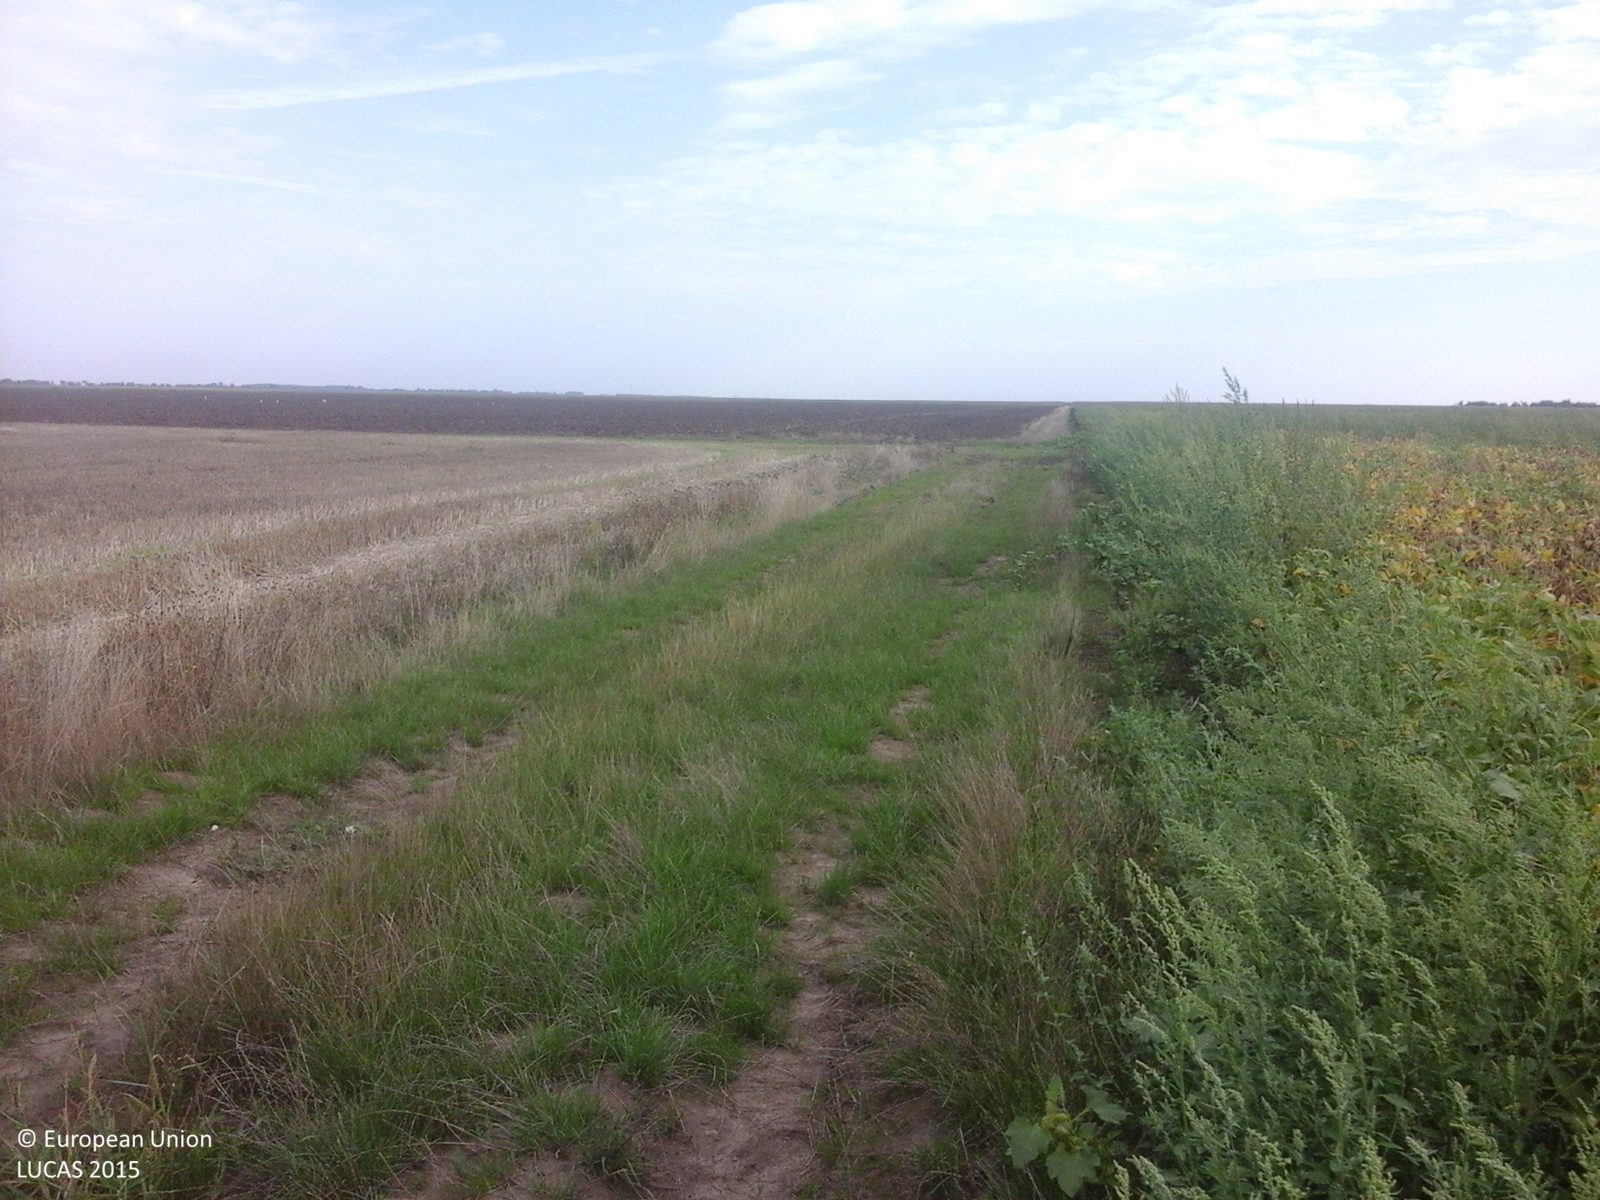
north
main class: Cropland
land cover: Soya
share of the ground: > 75 %
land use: Agriculture (excluding fallow land and kitchen gardens)
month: August
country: RO
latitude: 46.3009
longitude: 21.4218
